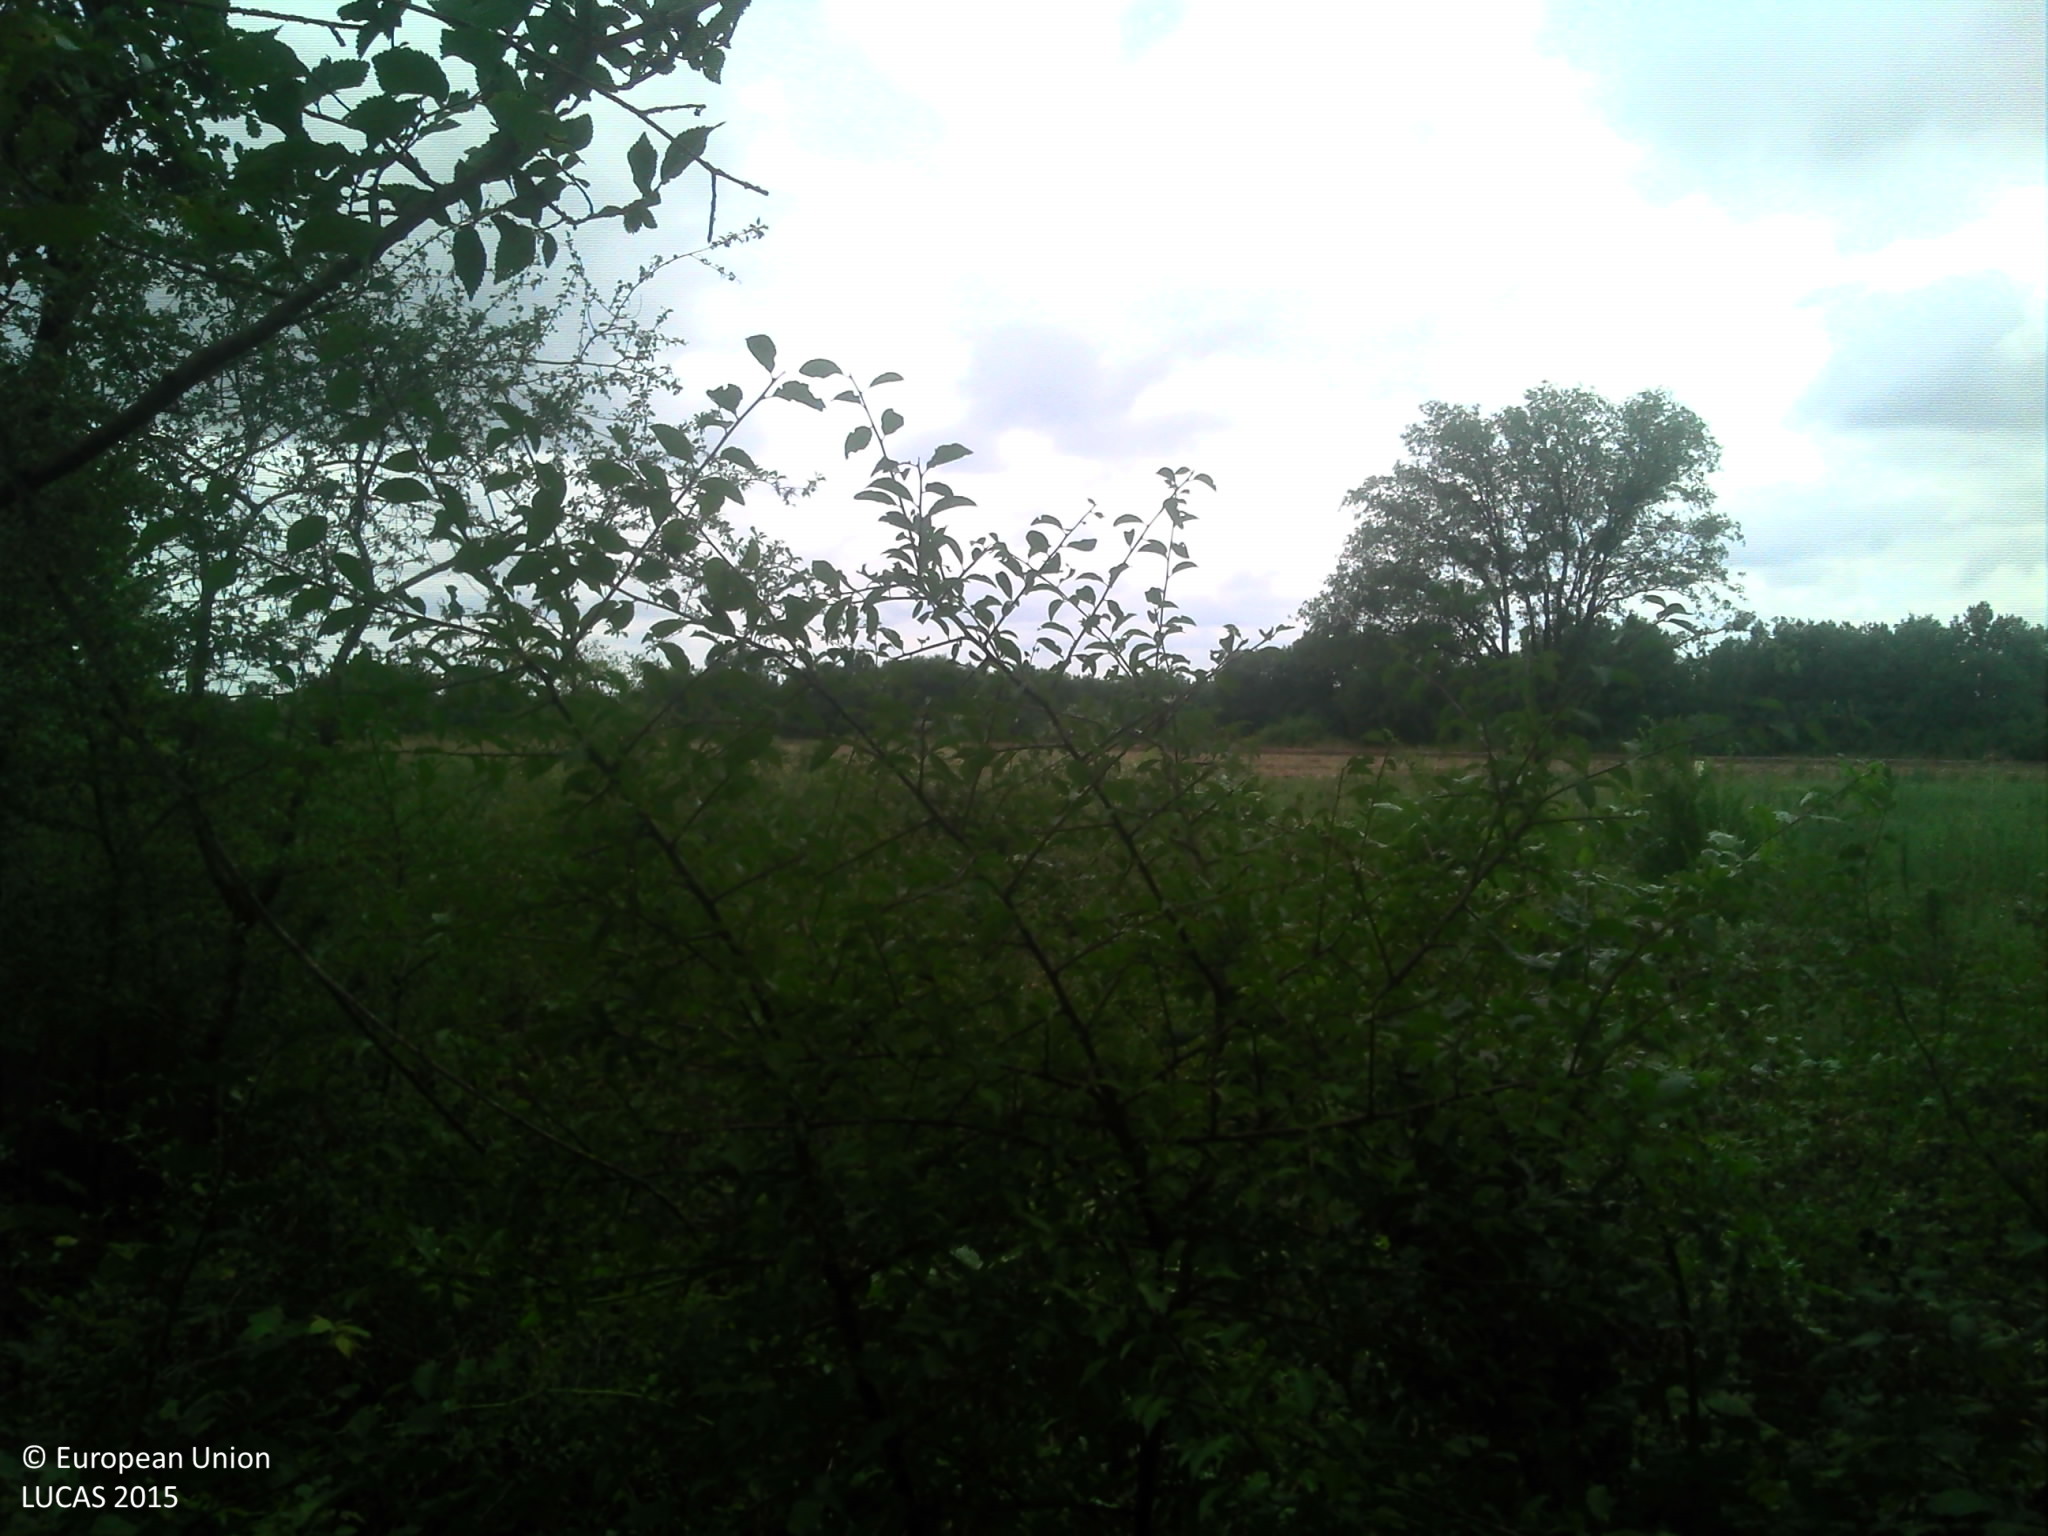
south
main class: Woodland
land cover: Broadleaved woodland
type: boreal forest
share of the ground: > 75 %
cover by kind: shrubs 50 %, broadleaved forest trees 40 %, herbaceous plants 10 %
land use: Forestry
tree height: > 5 m
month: August
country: FR
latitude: 43.5515
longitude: 1.3253
